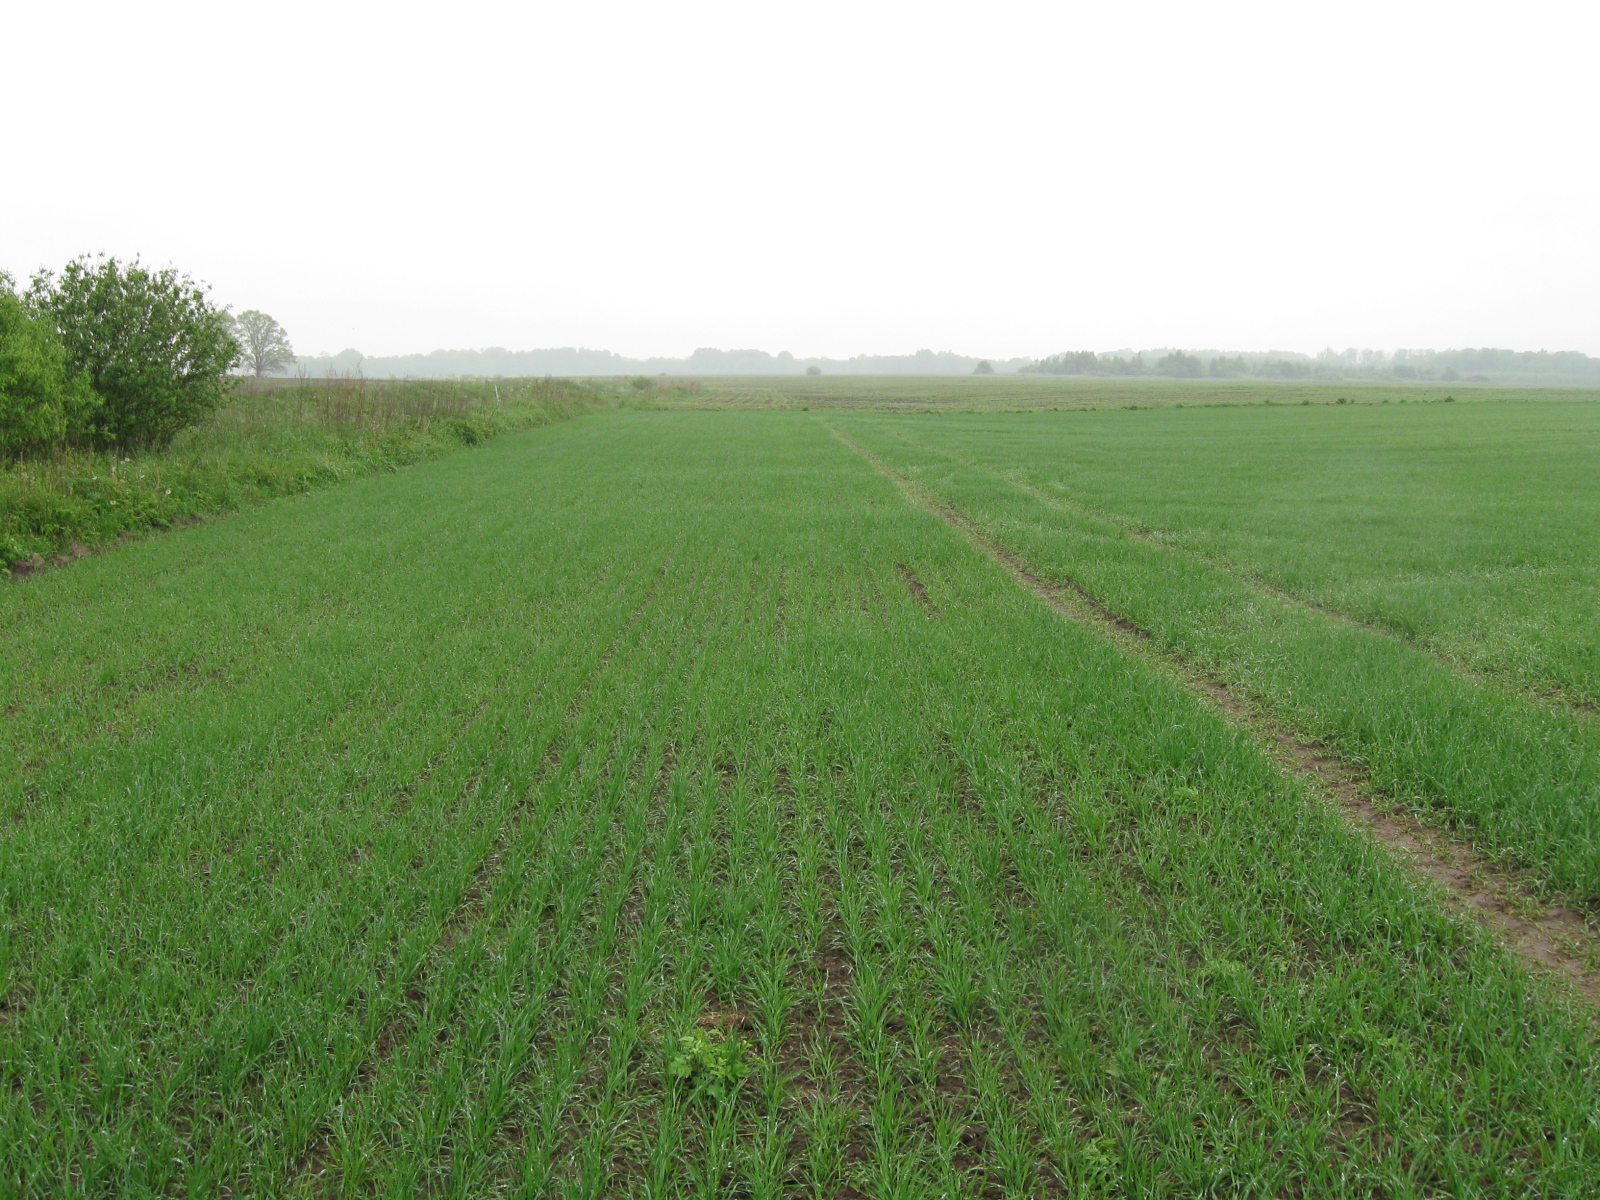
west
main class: Cropland
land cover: Common wheat
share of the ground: > 75 %
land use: Agriculture (excluding fallow land and kitchen gardens)
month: May
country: LT
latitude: 55.0052
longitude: 22.7149
